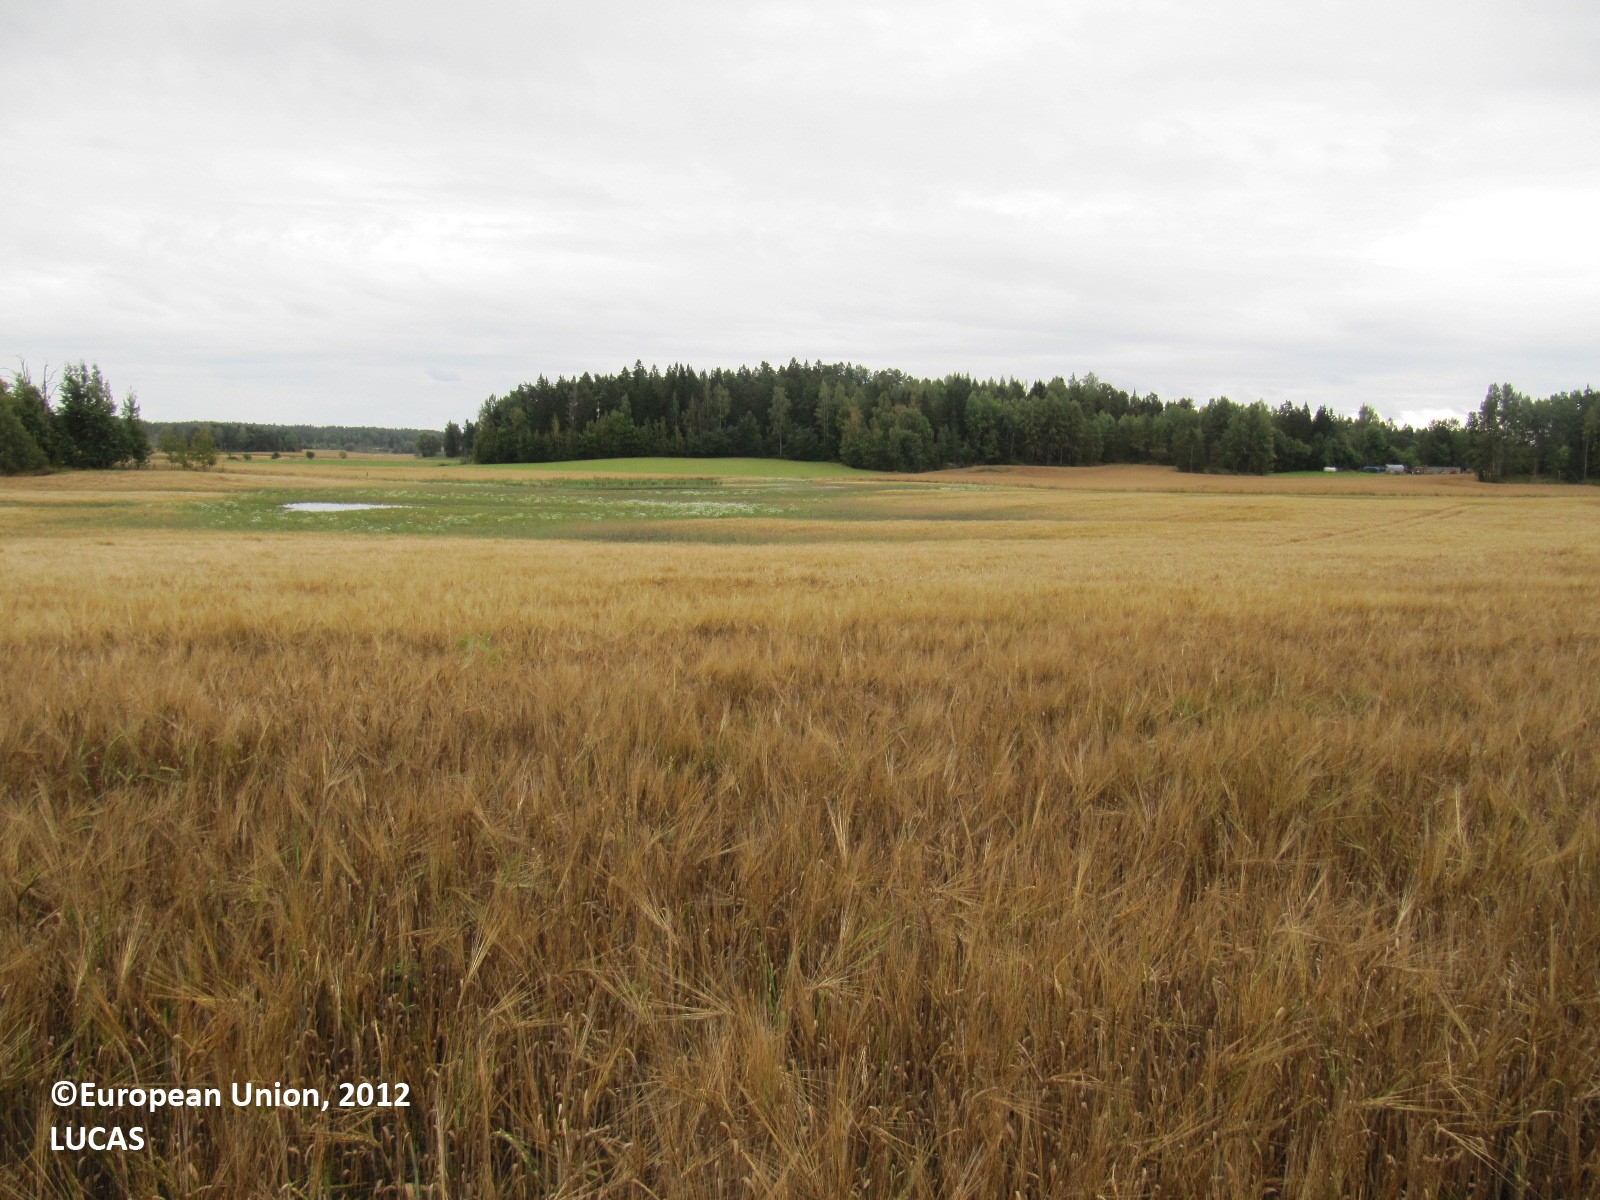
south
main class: Cropland
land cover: Barley
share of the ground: > 75 %
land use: Agriculture (excluding fallow land and kitchen gardens)
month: September
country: FI
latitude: 60.0583
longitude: 24.0566
